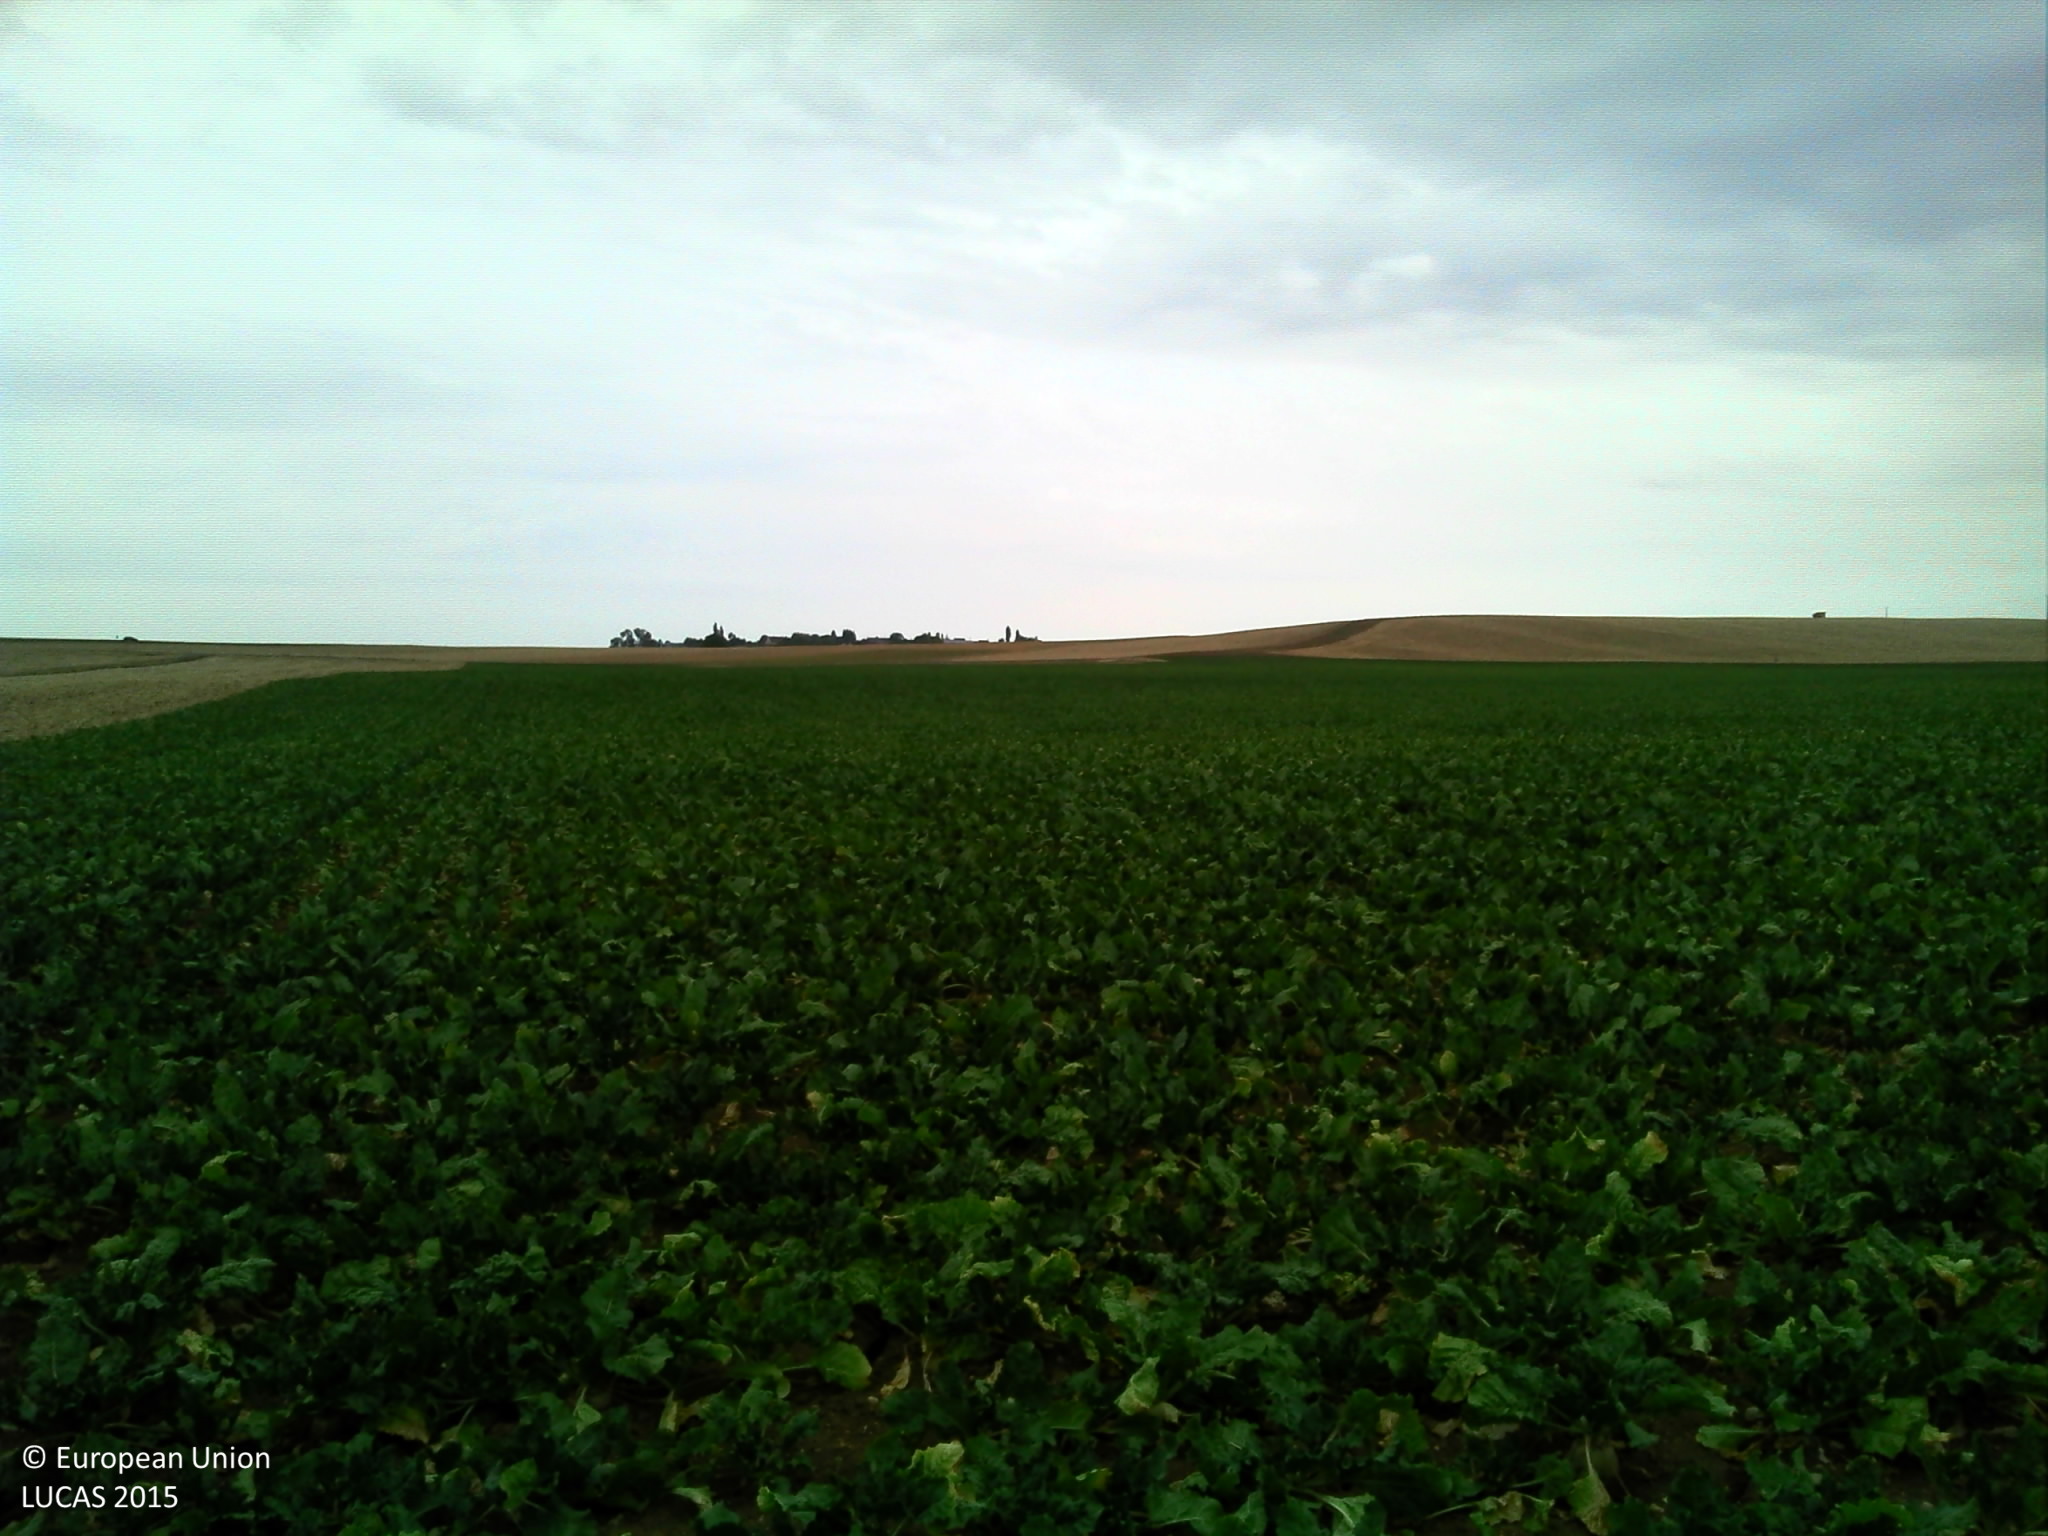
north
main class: Cropland
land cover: Sugar beet
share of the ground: > 75 %
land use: Agriculture (excluding fallow land and kitchen gardens)
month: August
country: FR
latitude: 48.2222
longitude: 2.5196
